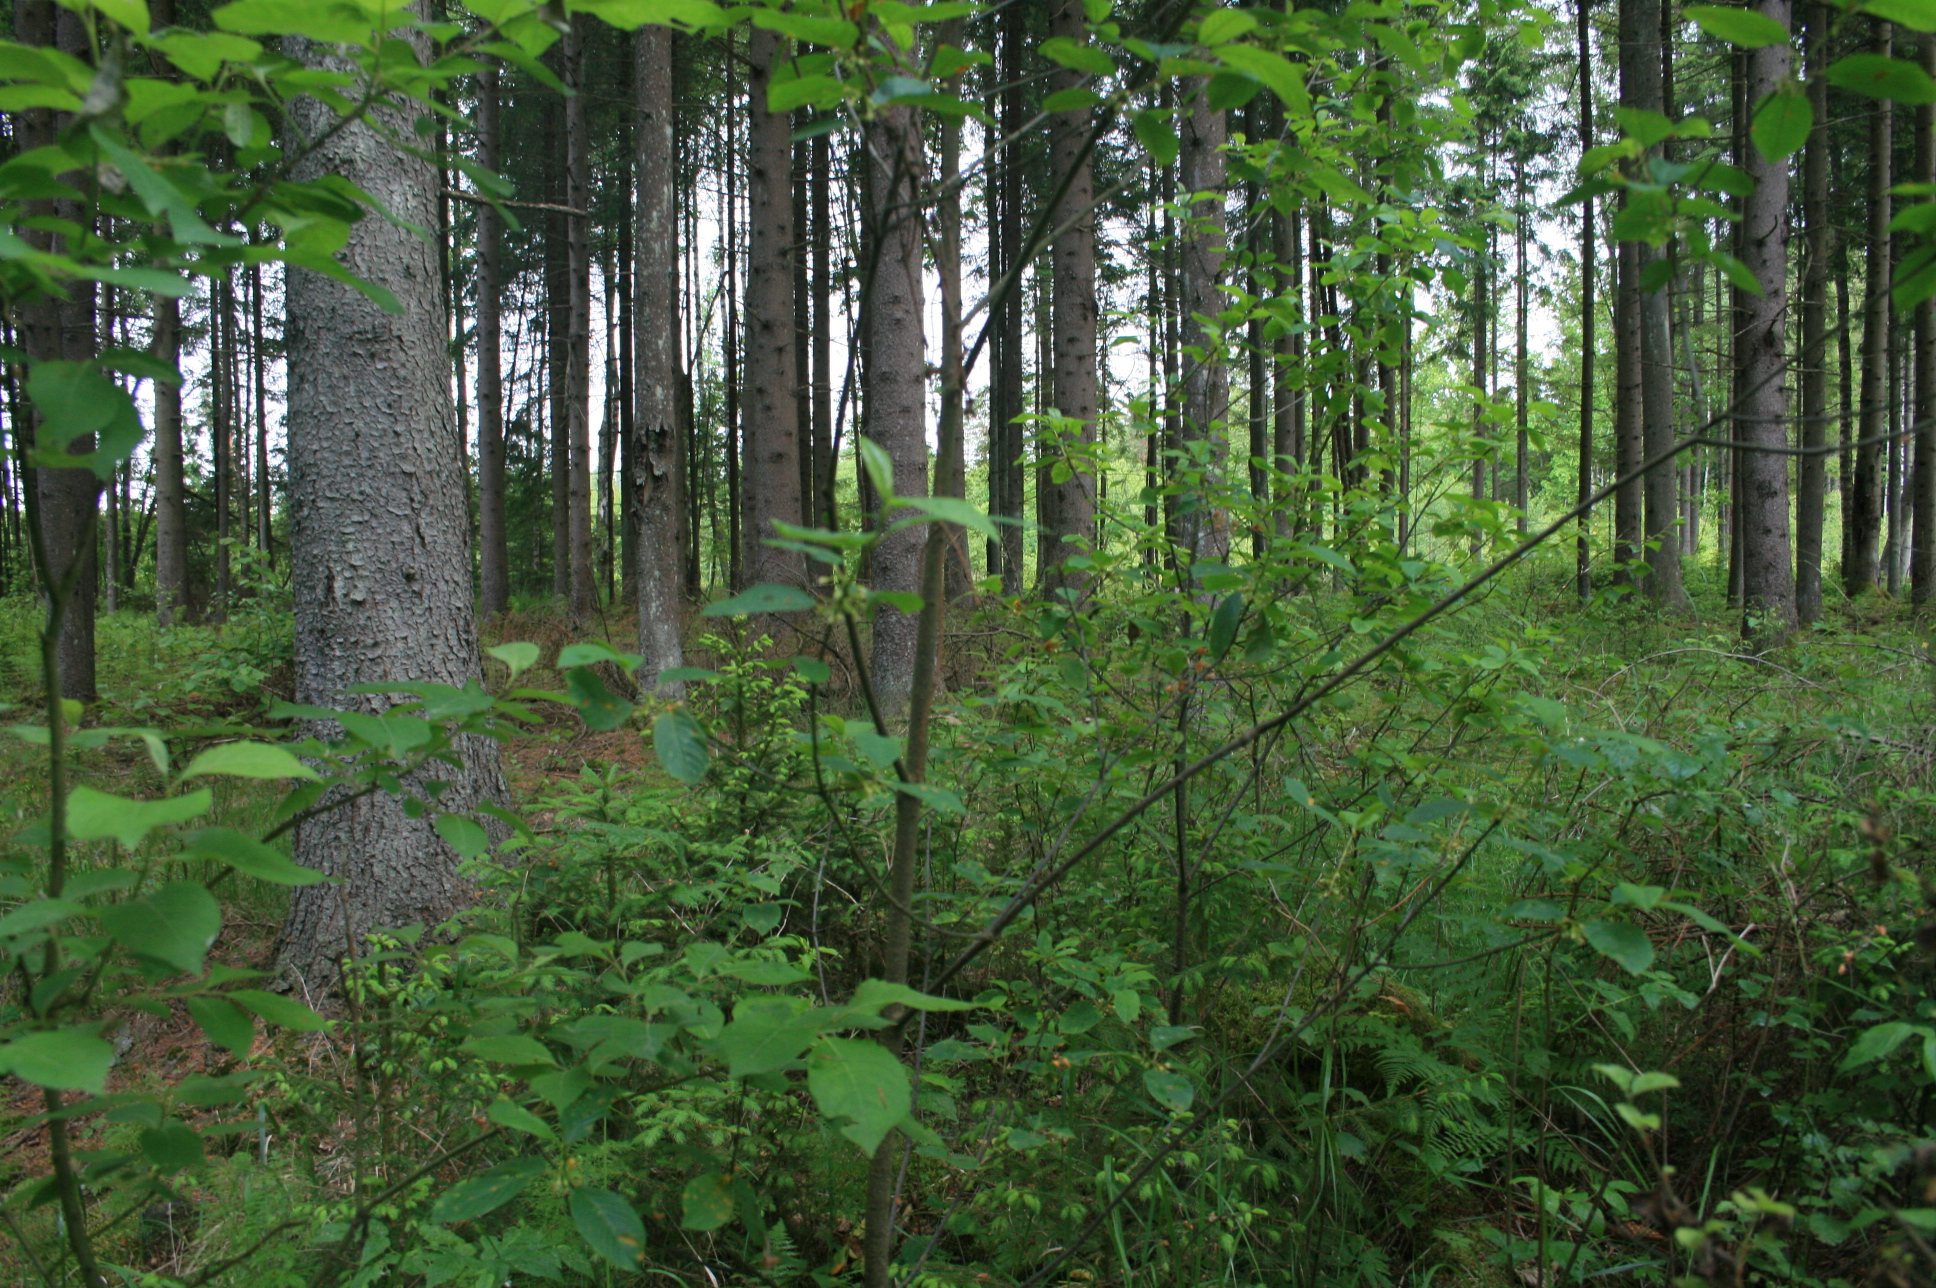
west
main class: Woodland
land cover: Spruce dominated mixed woodland
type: hemiboreal forest and nemoral coniferous forest and mixed broadleaved-coniferous forest
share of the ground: 50 - 75 %
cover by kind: coniferous forest trees 50 %, herbaceous plants 30 %, broadleaved forest trees 20 %
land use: Forestry
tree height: > 5 m
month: June
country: LT
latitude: 55.3527
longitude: 22.1529
